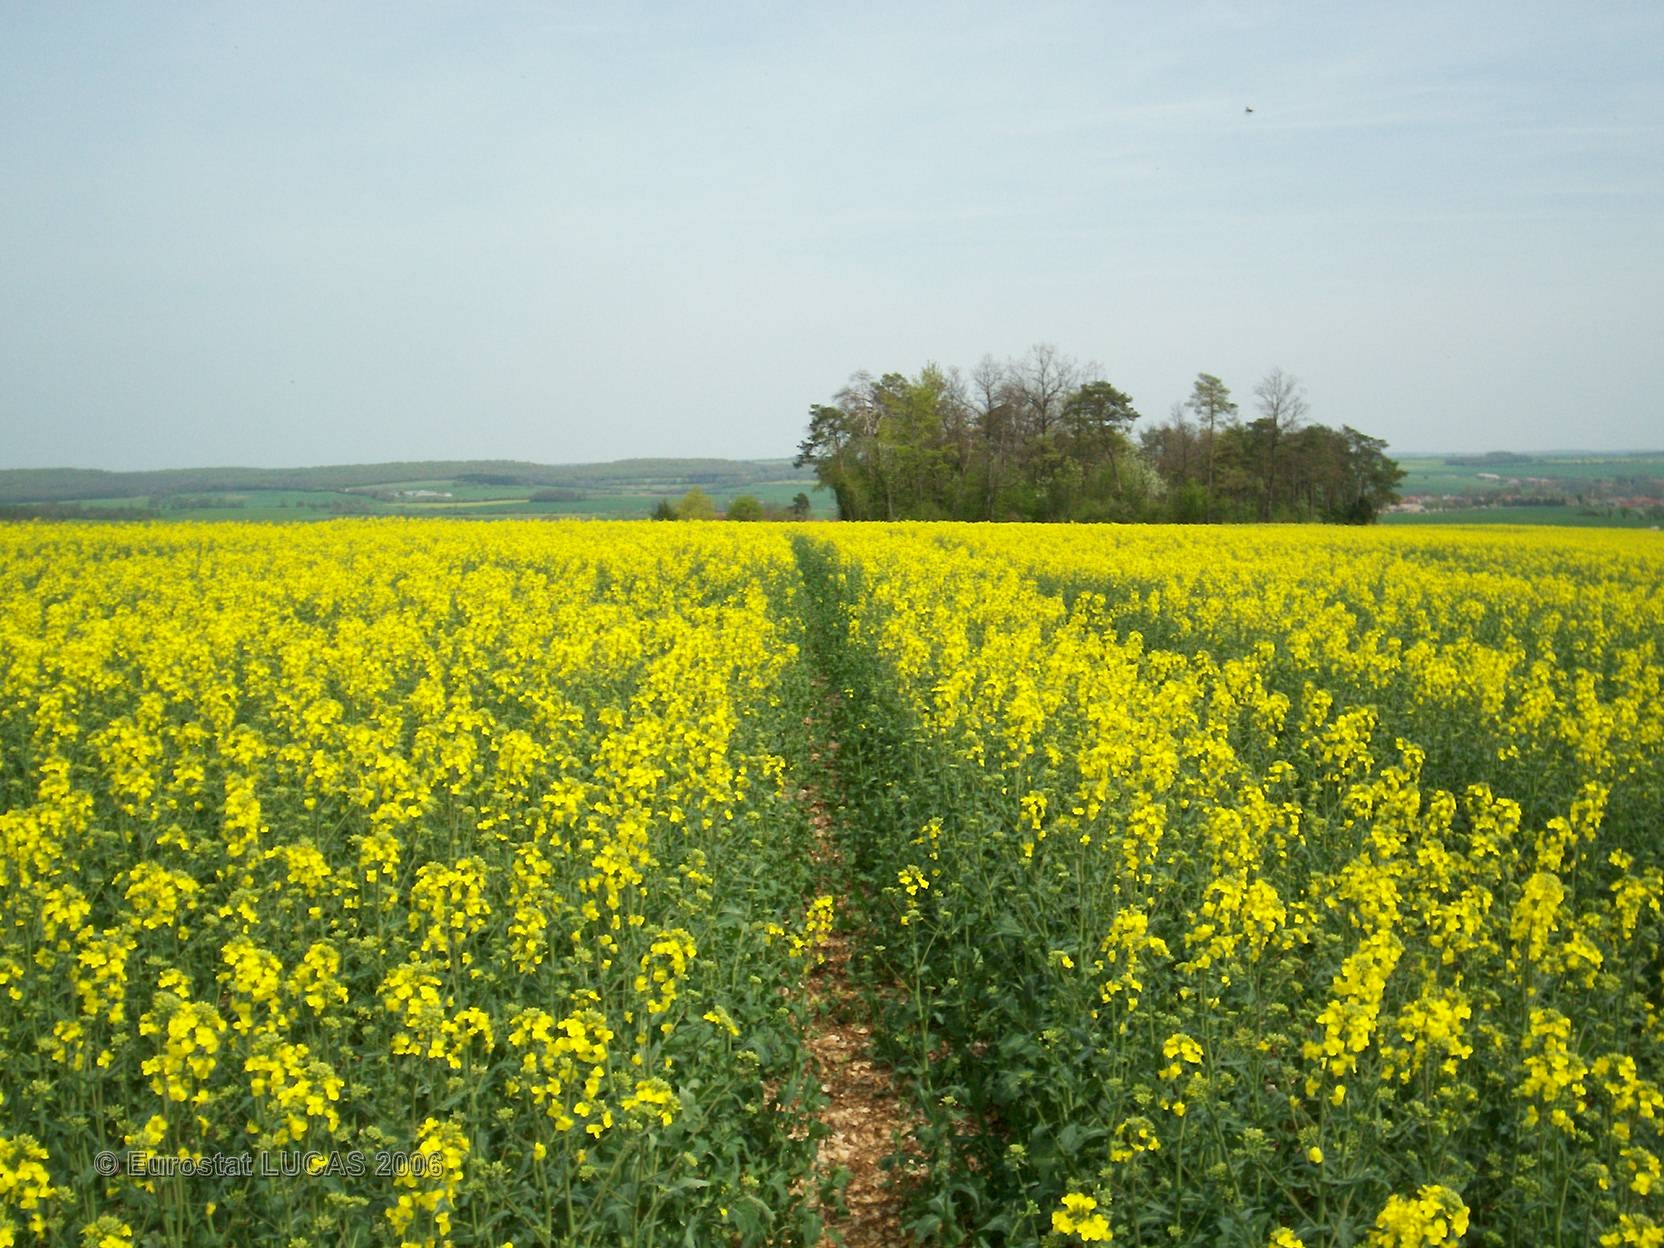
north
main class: Cropland
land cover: Rape and turnip rape
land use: Agriculture (excluding fallow land and kitchen gardens)
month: May
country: FR
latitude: 47.6202
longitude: 4.5570
